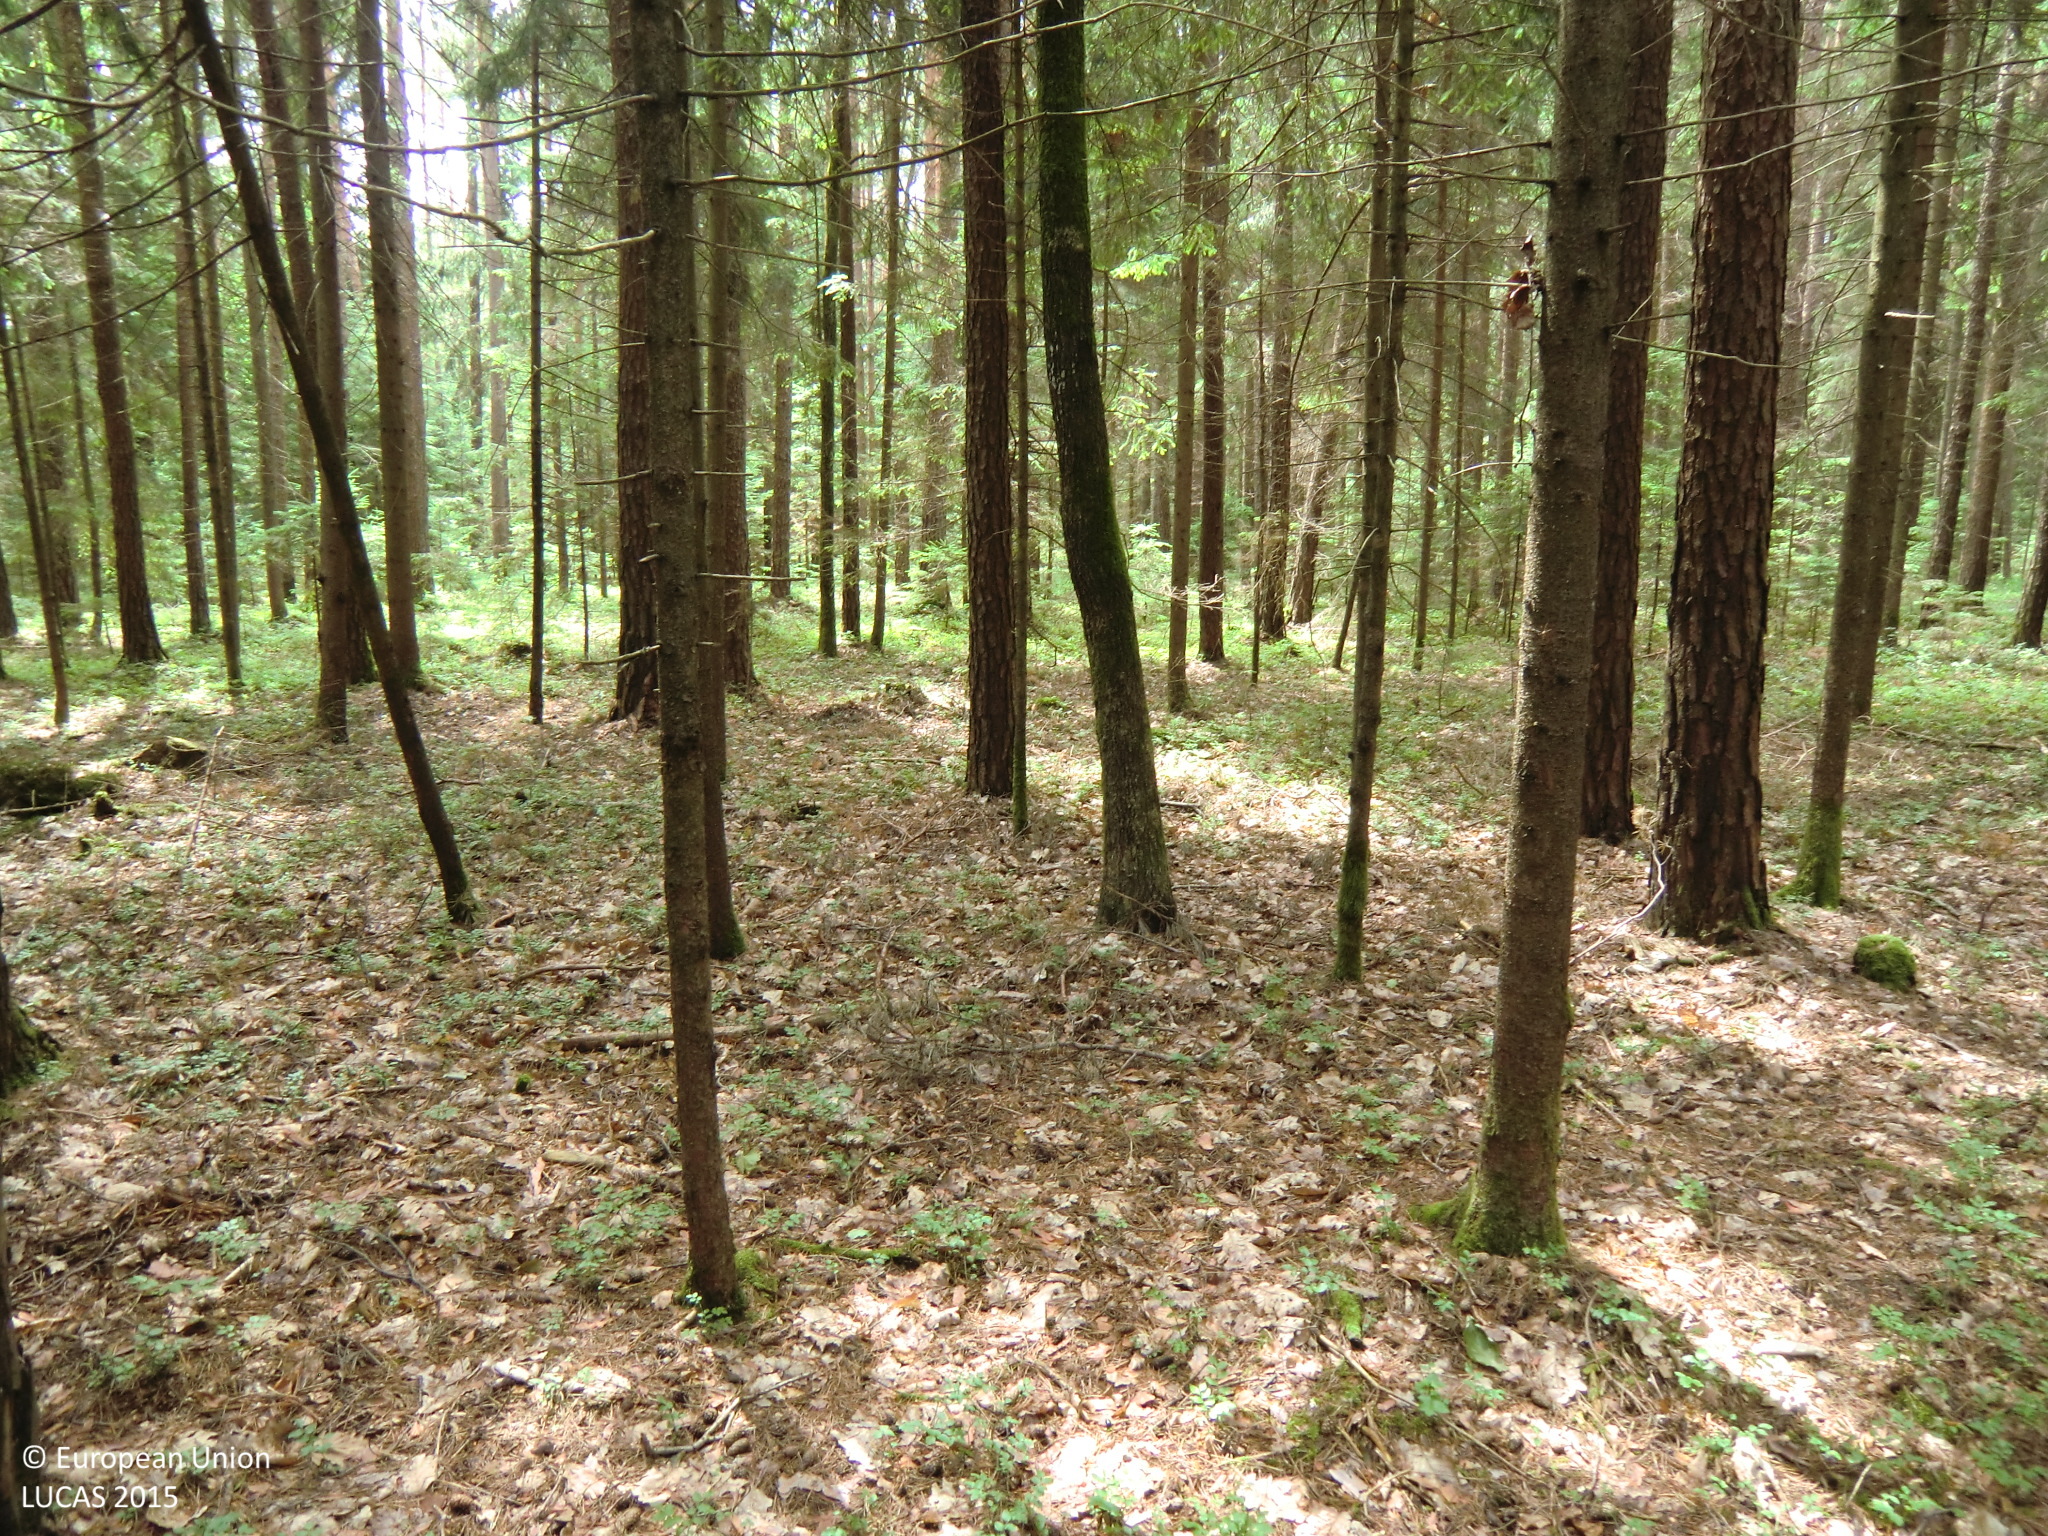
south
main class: Woodland
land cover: Pine dominated coniferous woodland
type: hemiboreal forest and nemoral coniferous forest and mixed broadleaved-coniferous forest
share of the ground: 50 - 75 %
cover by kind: coniferous forest trees 60 %, shrubs 20 %, unconsolidated bare surface 20 %
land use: Forestry
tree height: > 5 m
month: June
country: AT
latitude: 47.2623
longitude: 16.0679
